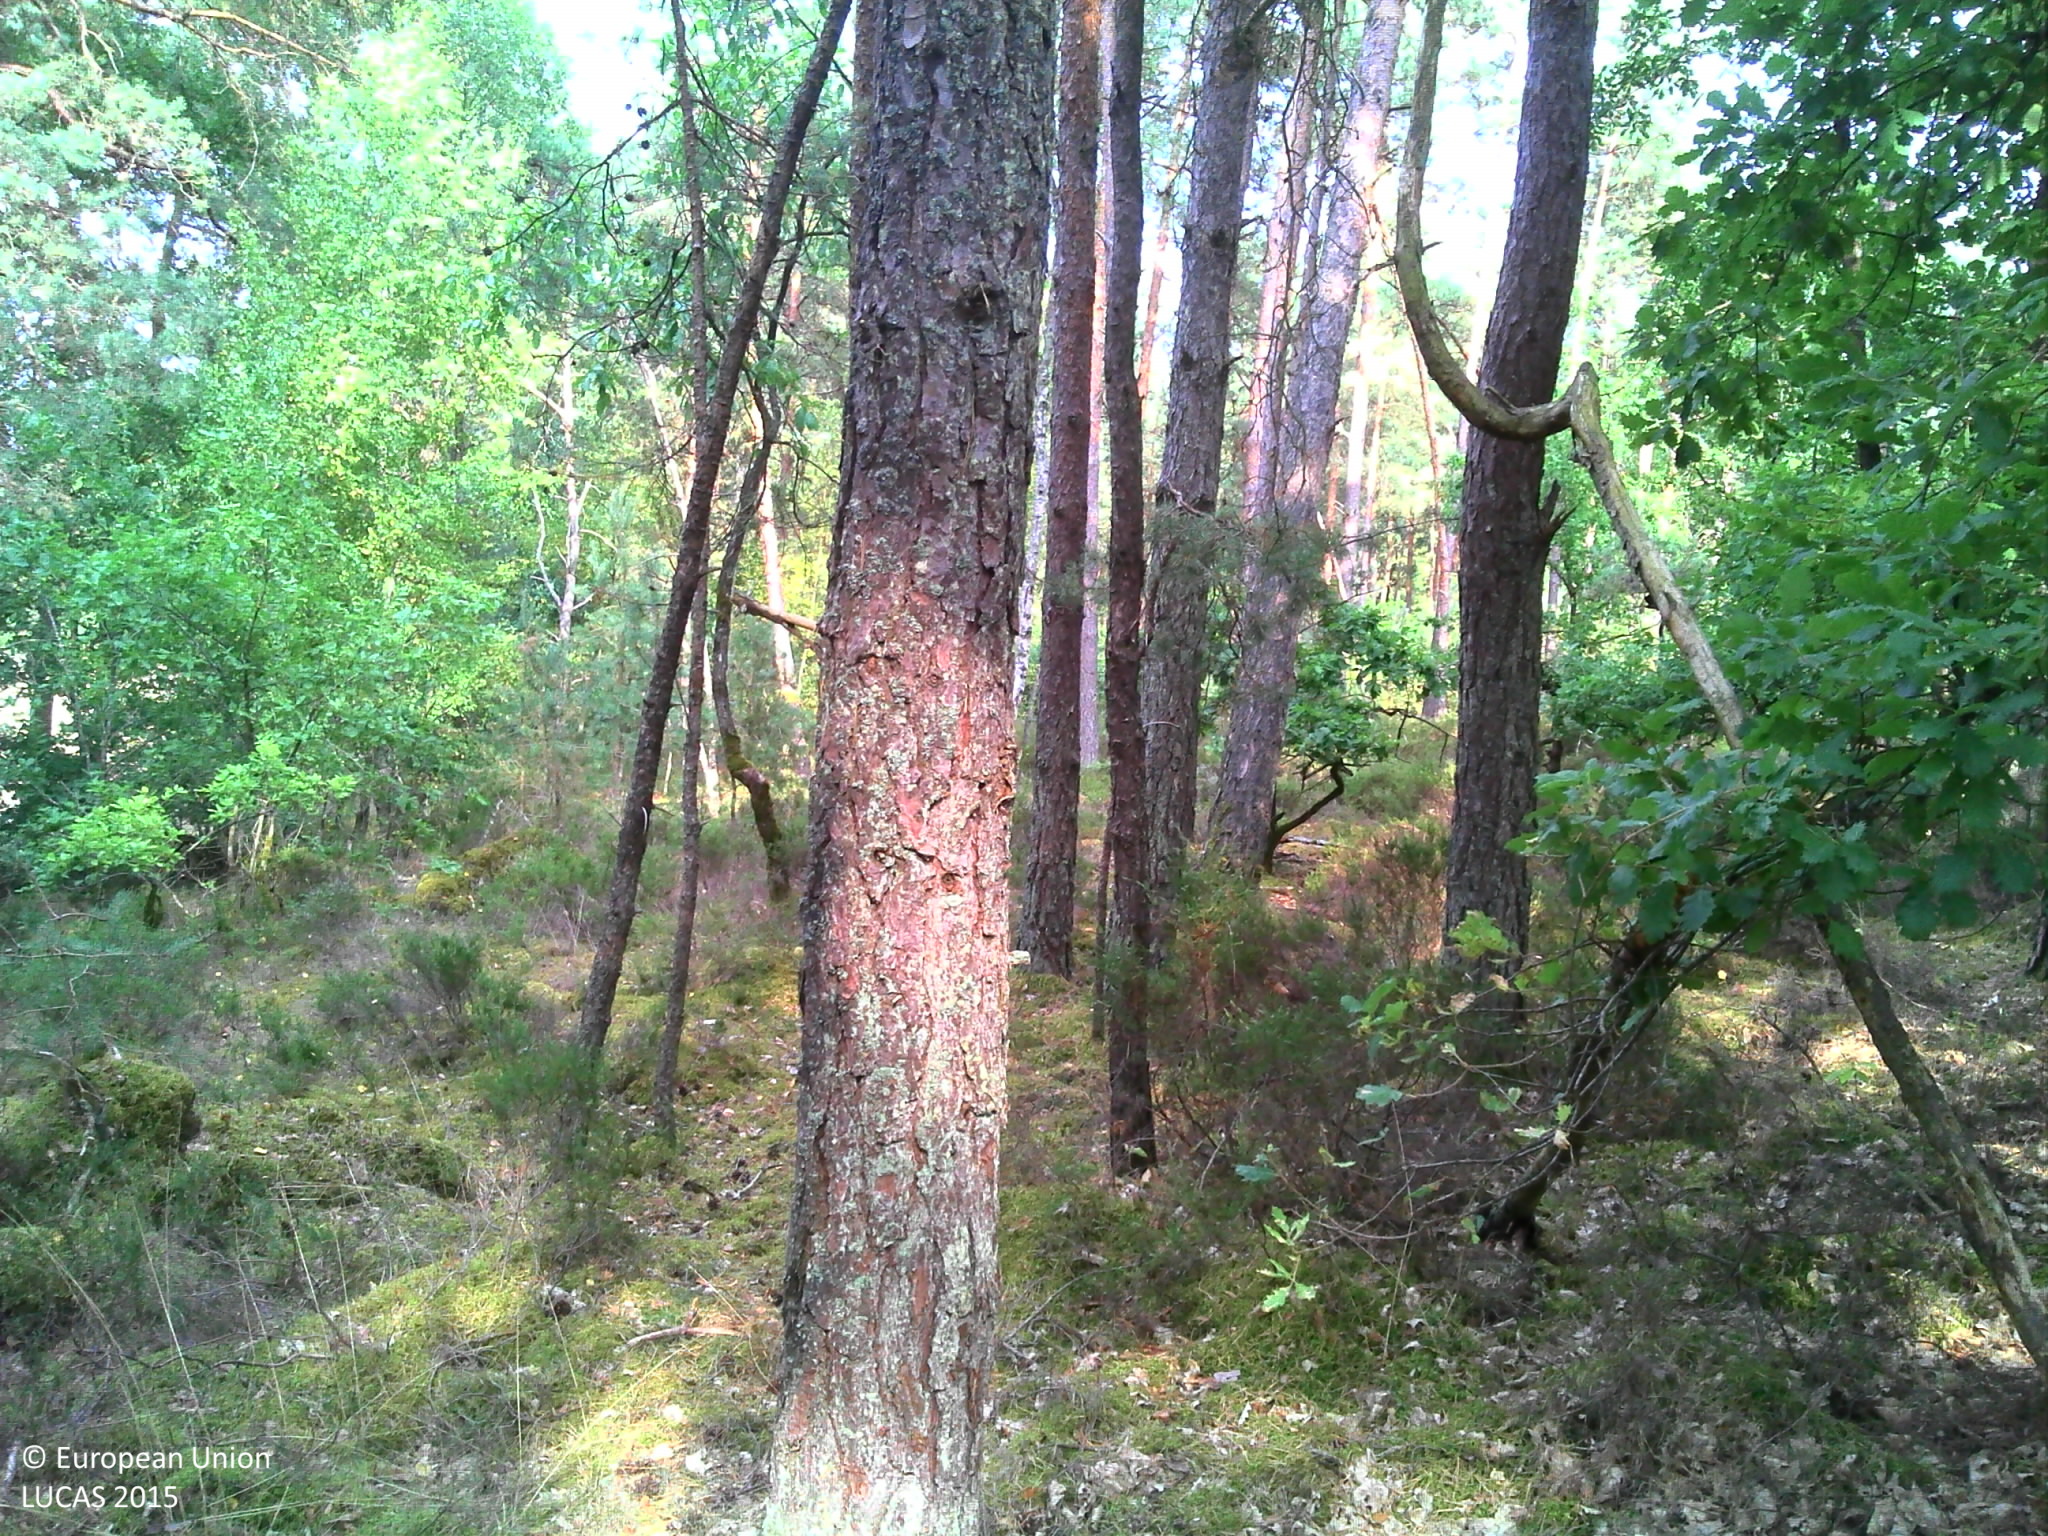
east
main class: Woodland
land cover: Pine dominated mixed woodland
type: acidophilous oak and oak-birch forest
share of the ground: > 75 %
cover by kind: lichens and mosses 50 %, coniferous forest trees 30 %, broadleaved forest trees 10 %, shrubs 10 %
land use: Forestry
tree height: > 5 m
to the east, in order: Pine dominated mixed woodland
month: August
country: FR
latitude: 48.3295
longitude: 2.5036
